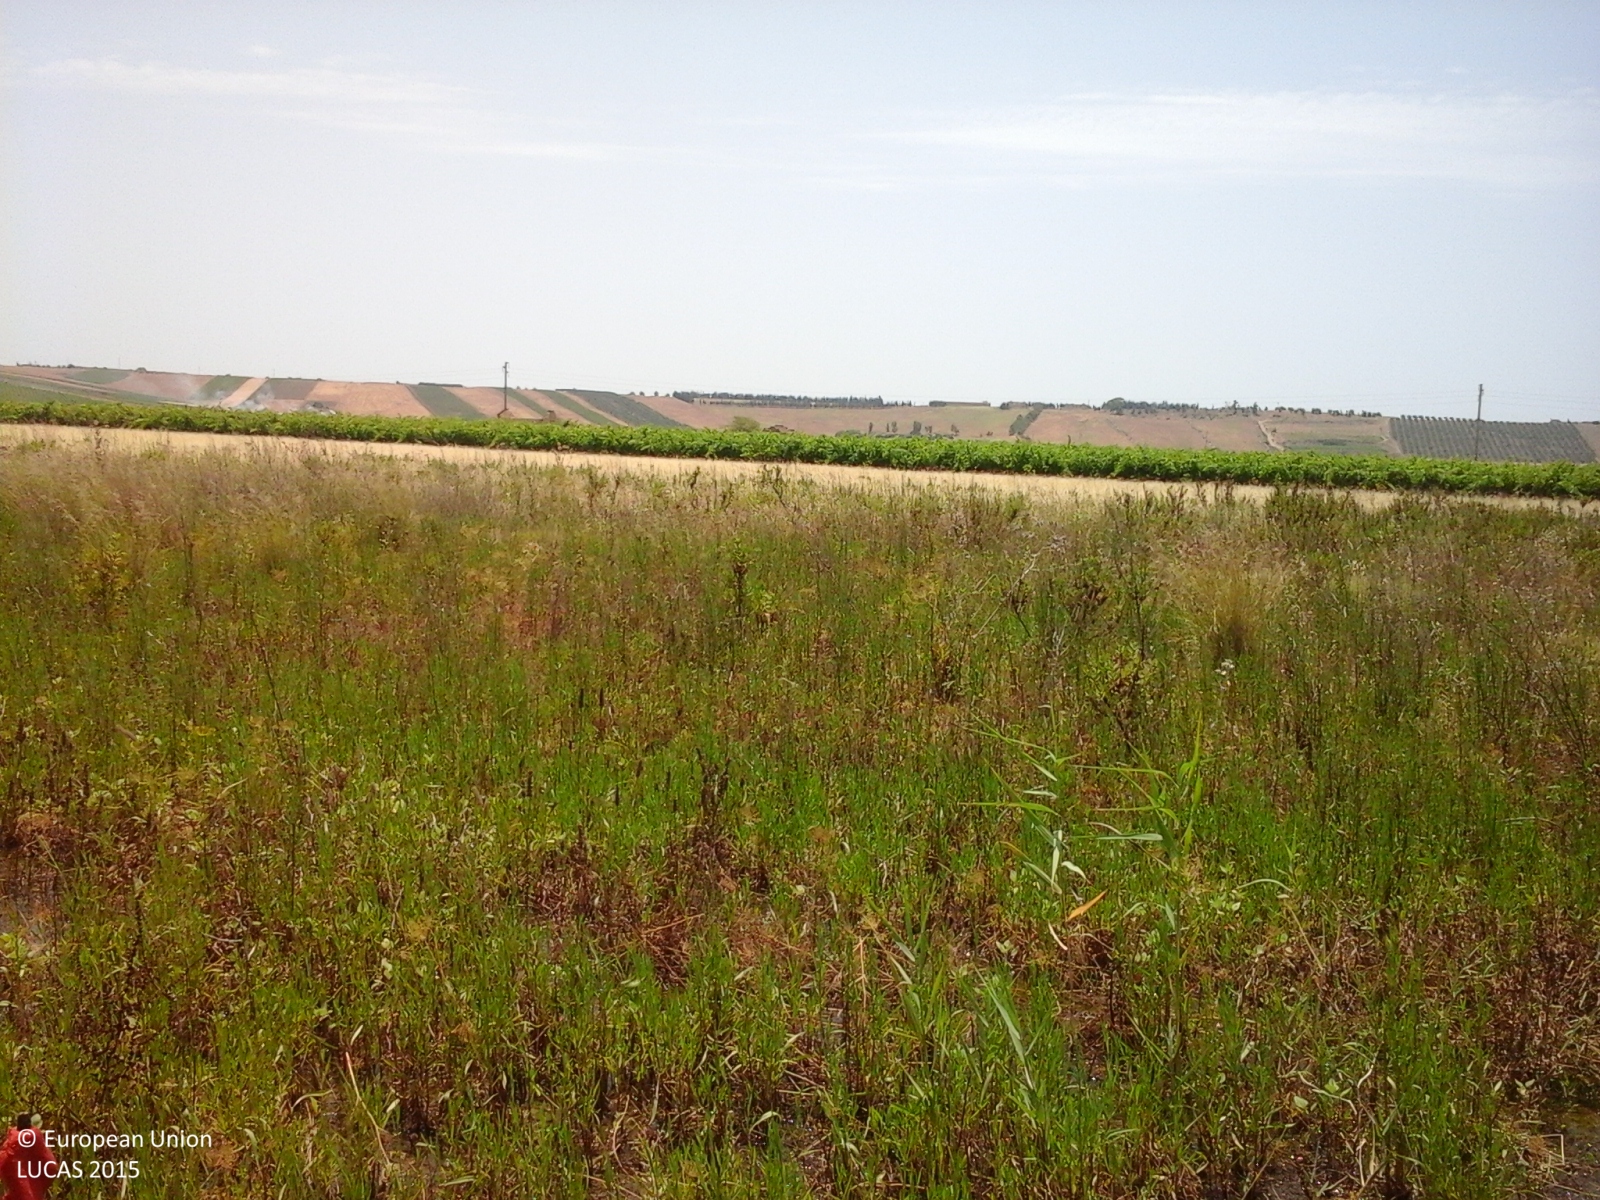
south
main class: Grassland
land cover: Spontaneously vegetated surfaces
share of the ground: > 75 %
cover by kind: herbaceous plants 100 %
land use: Fallow land
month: May
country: IT
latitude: 37.6557
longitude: 12.6661
